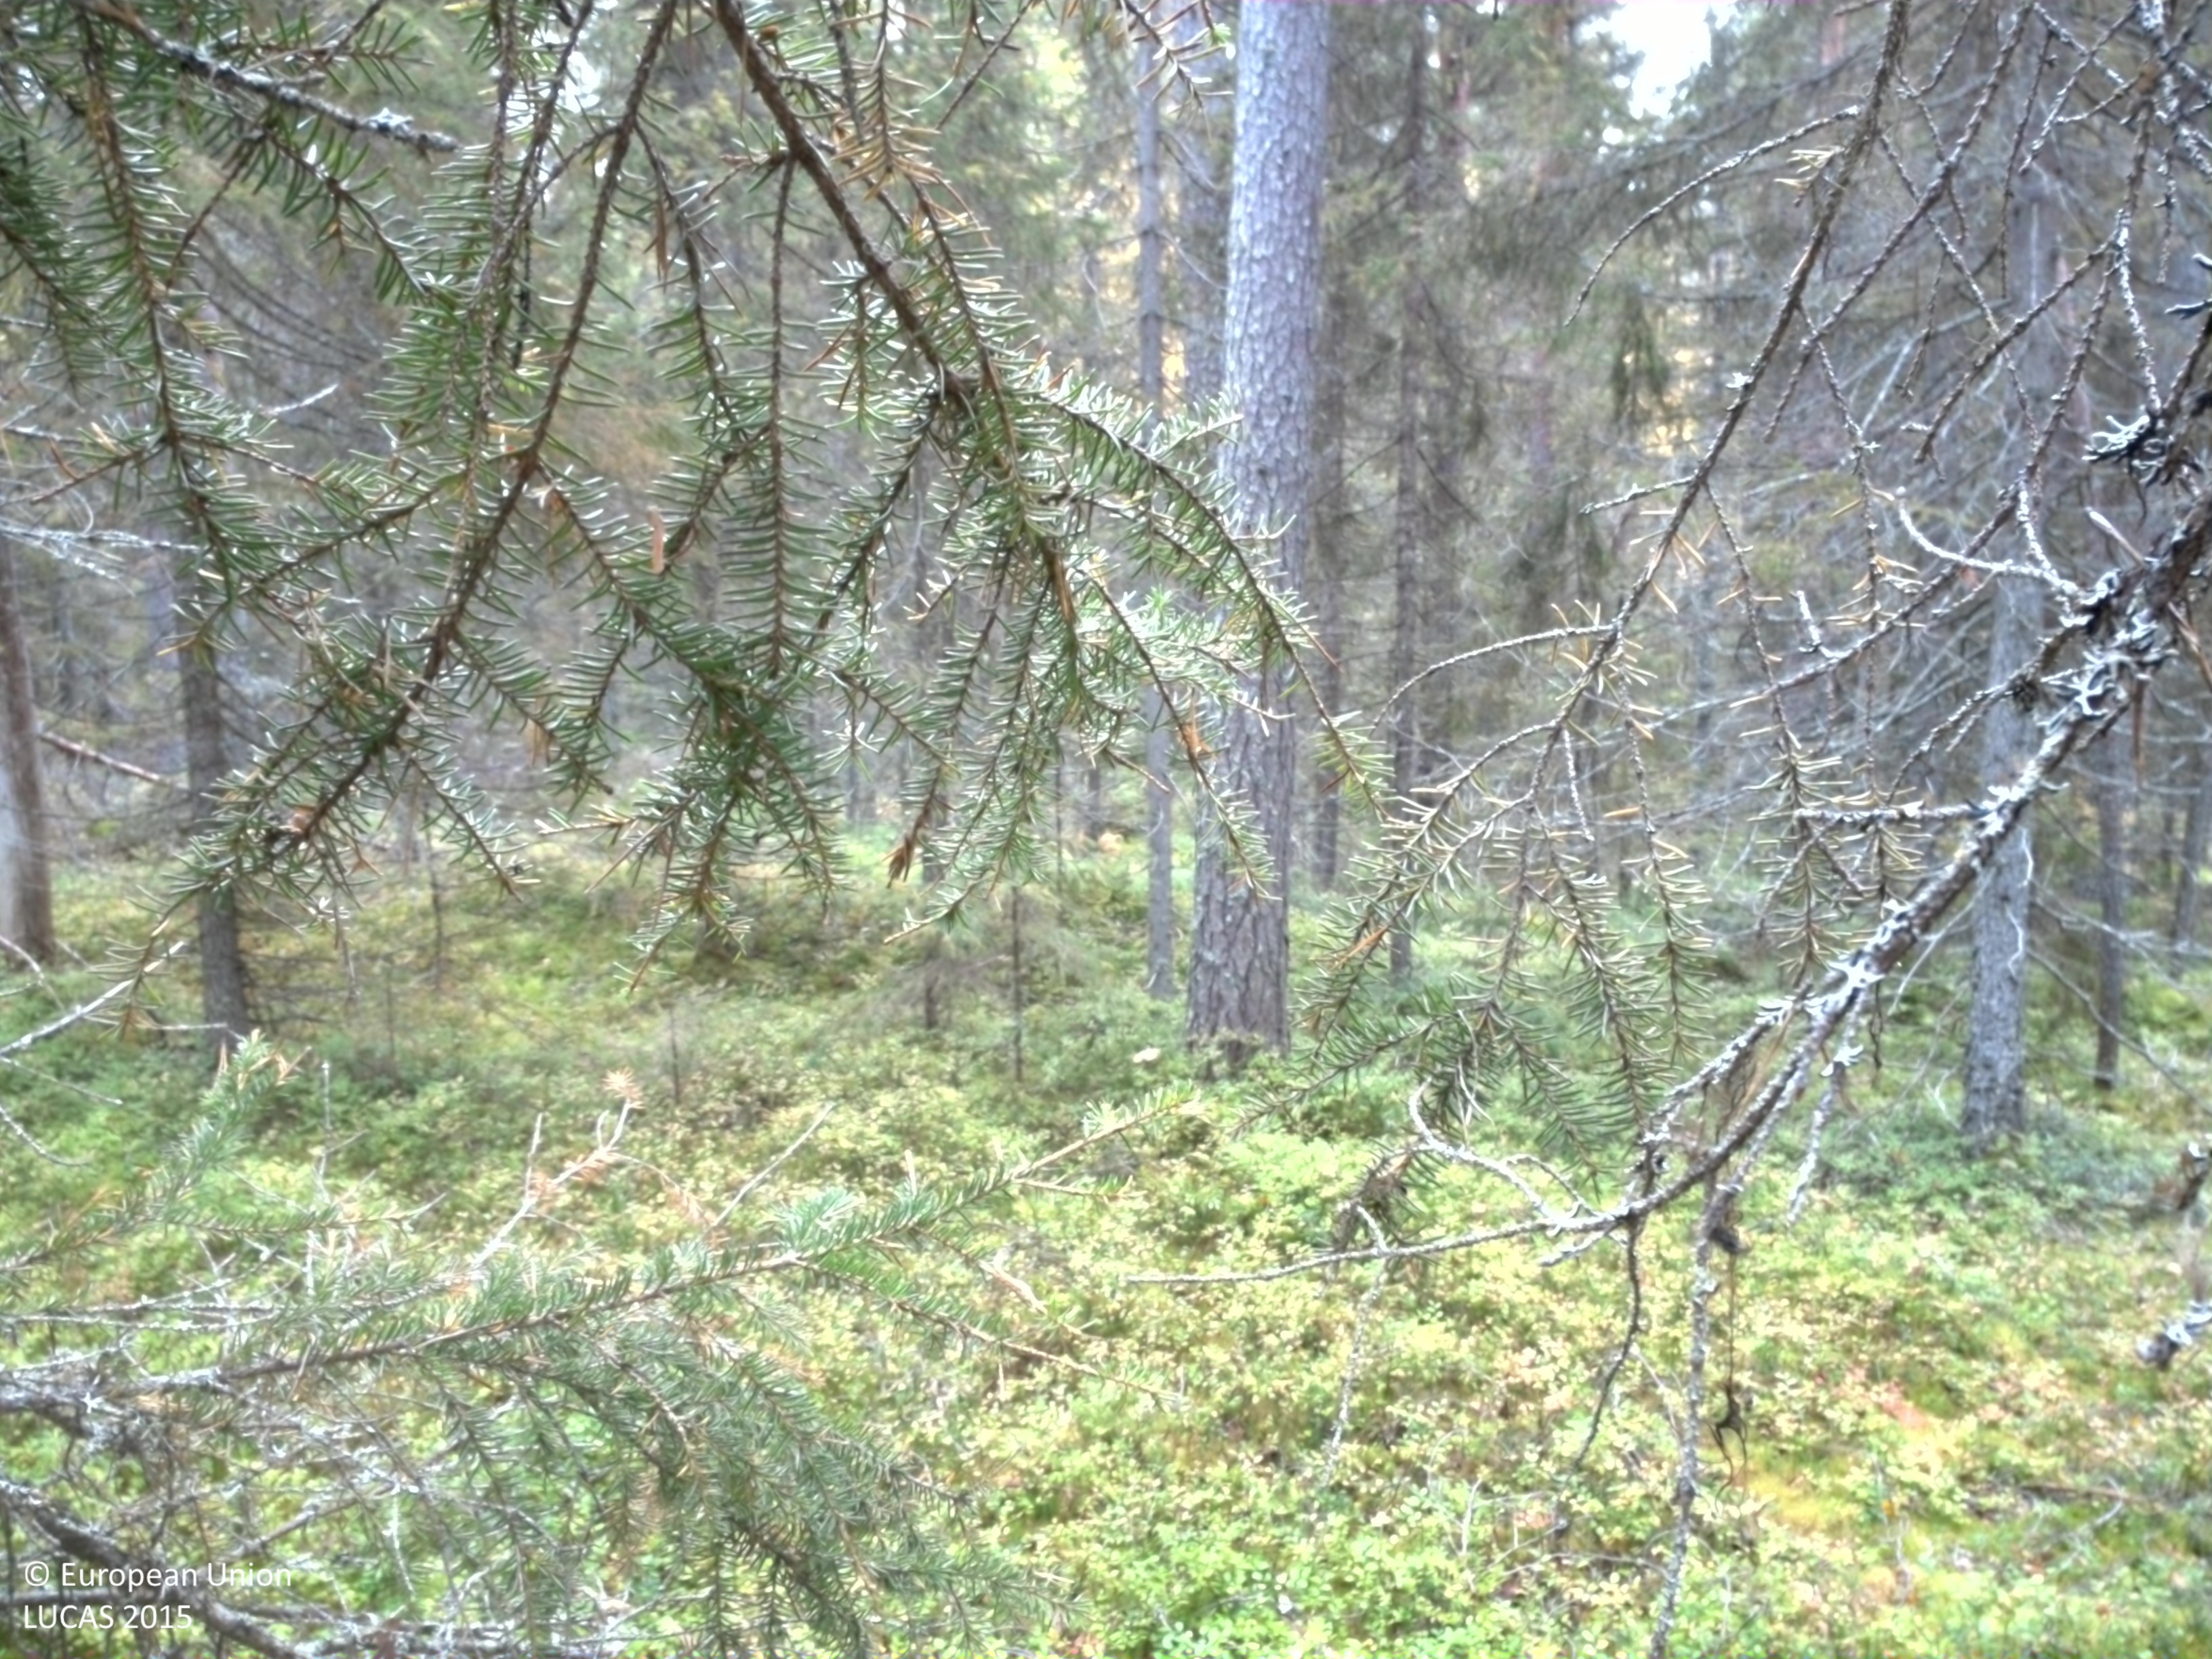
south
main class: Woodland
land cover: Pine dominated coniferous woodland
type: boreal forest
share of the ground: 25 - 50 %
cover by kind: shrubs 65 %, coniferous forest trees 35 %
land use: Forestry
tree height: > 5 m
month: September
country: SE
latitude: 65.8594
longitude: 21.8279
